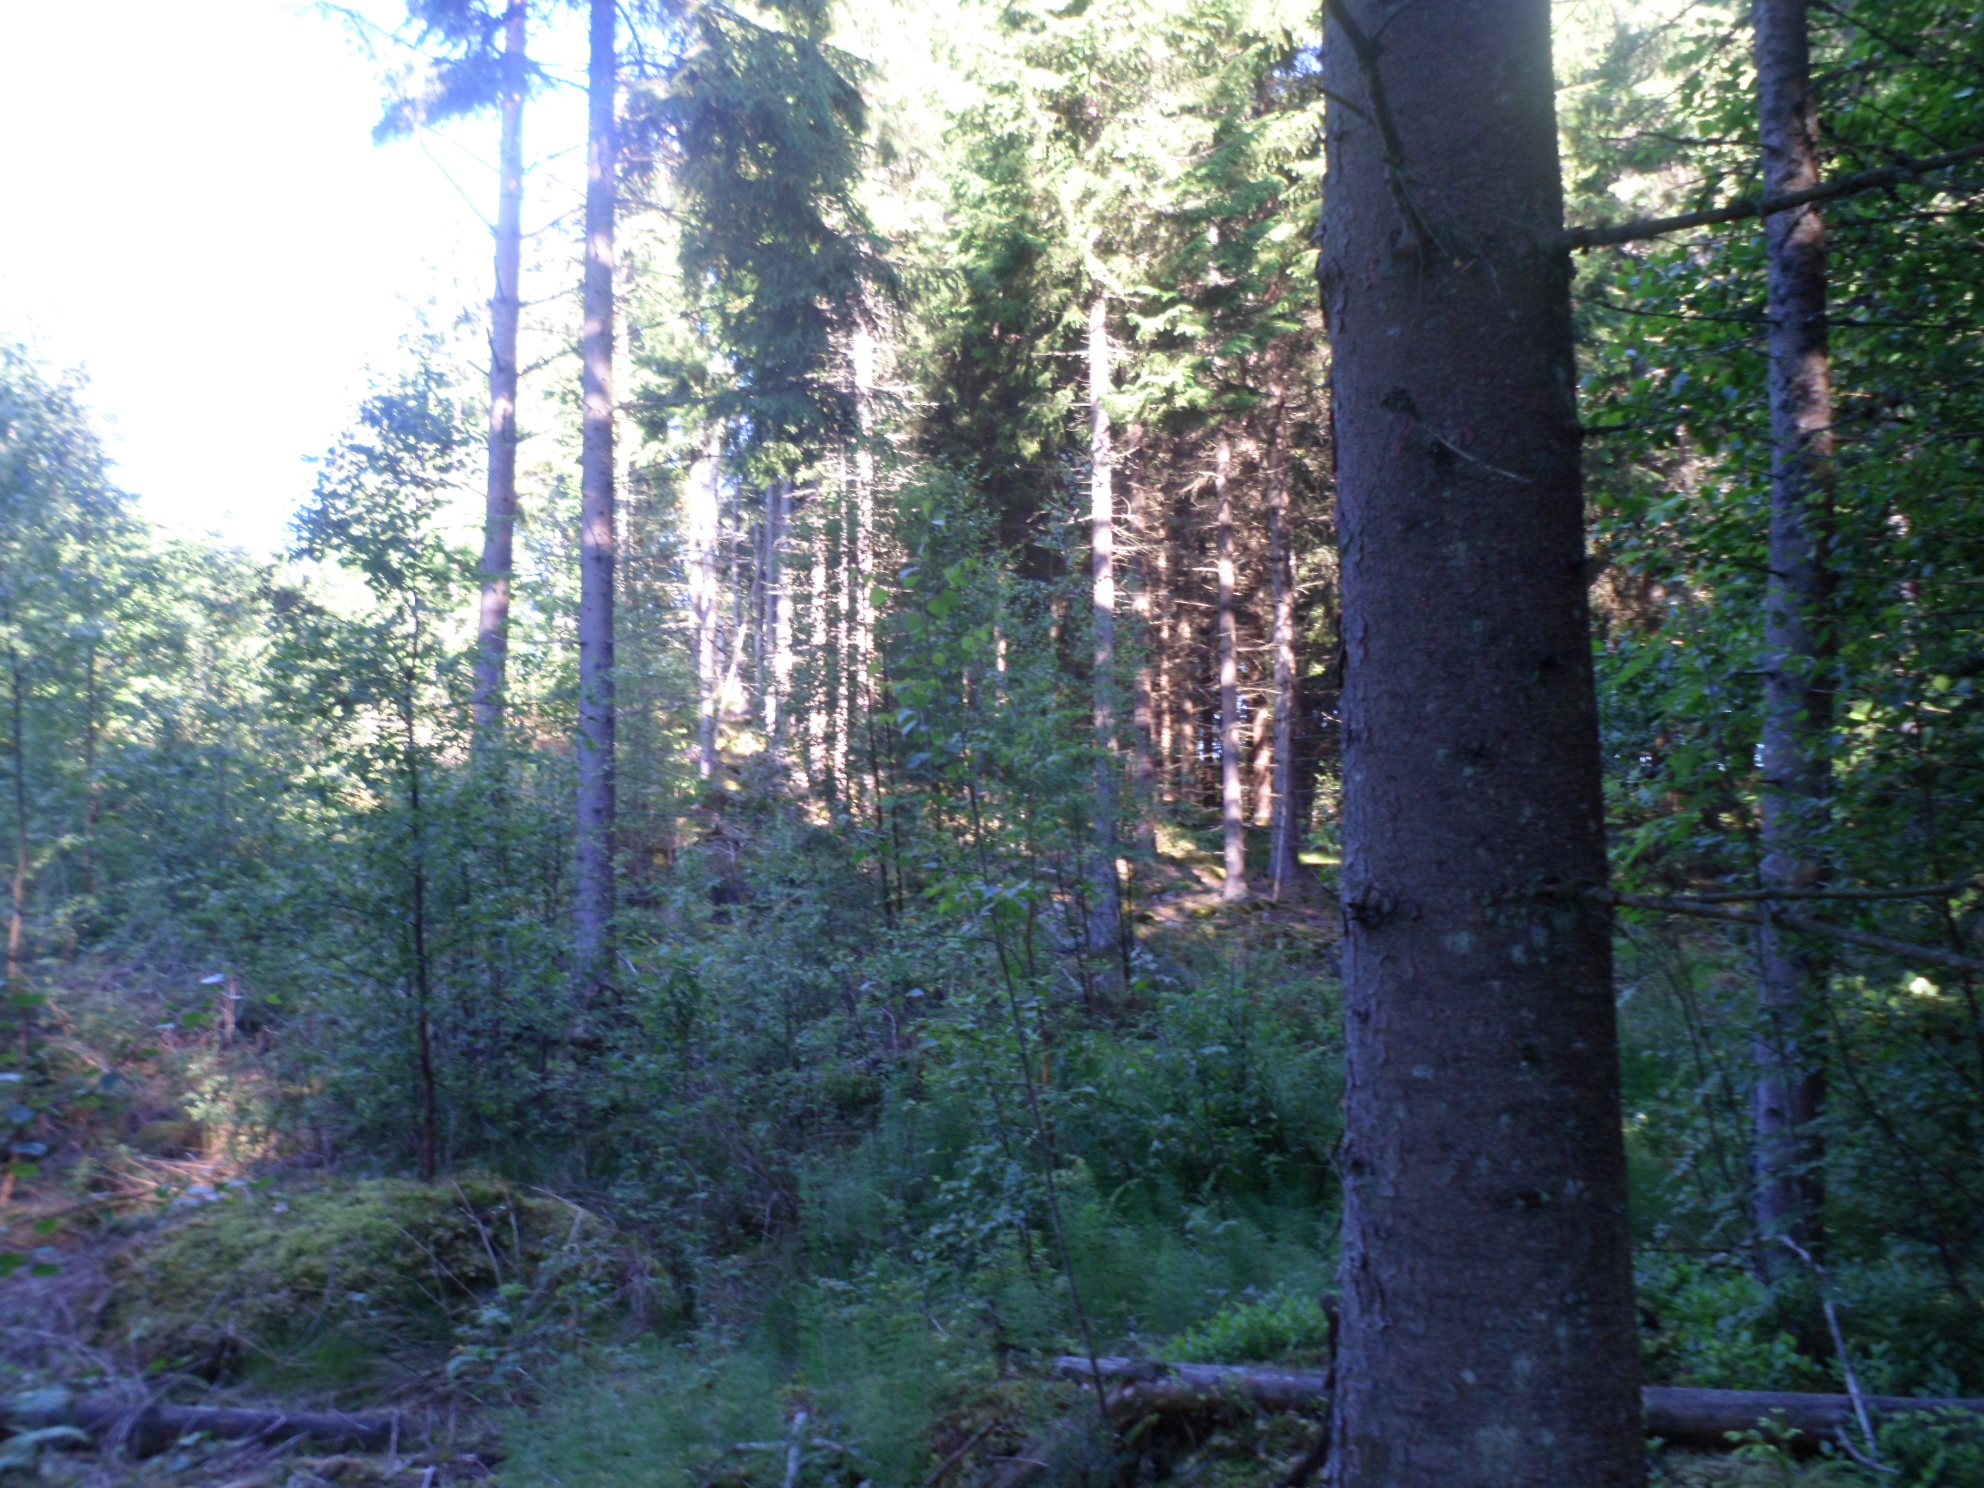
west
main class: Woodland
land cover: Spruce dominated coniferous woodland
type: boreal forest
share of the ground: 50 - 75 %
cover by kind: coniferous forest trees 55 %, lichens and mosses 20 %, broadleaved forest trees 10 %, shrubs 10 %, herbaceous plants 5 %
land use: Forestry
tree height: > 5 m
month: July
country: SE
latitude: 57.2428
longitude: 14.5200
